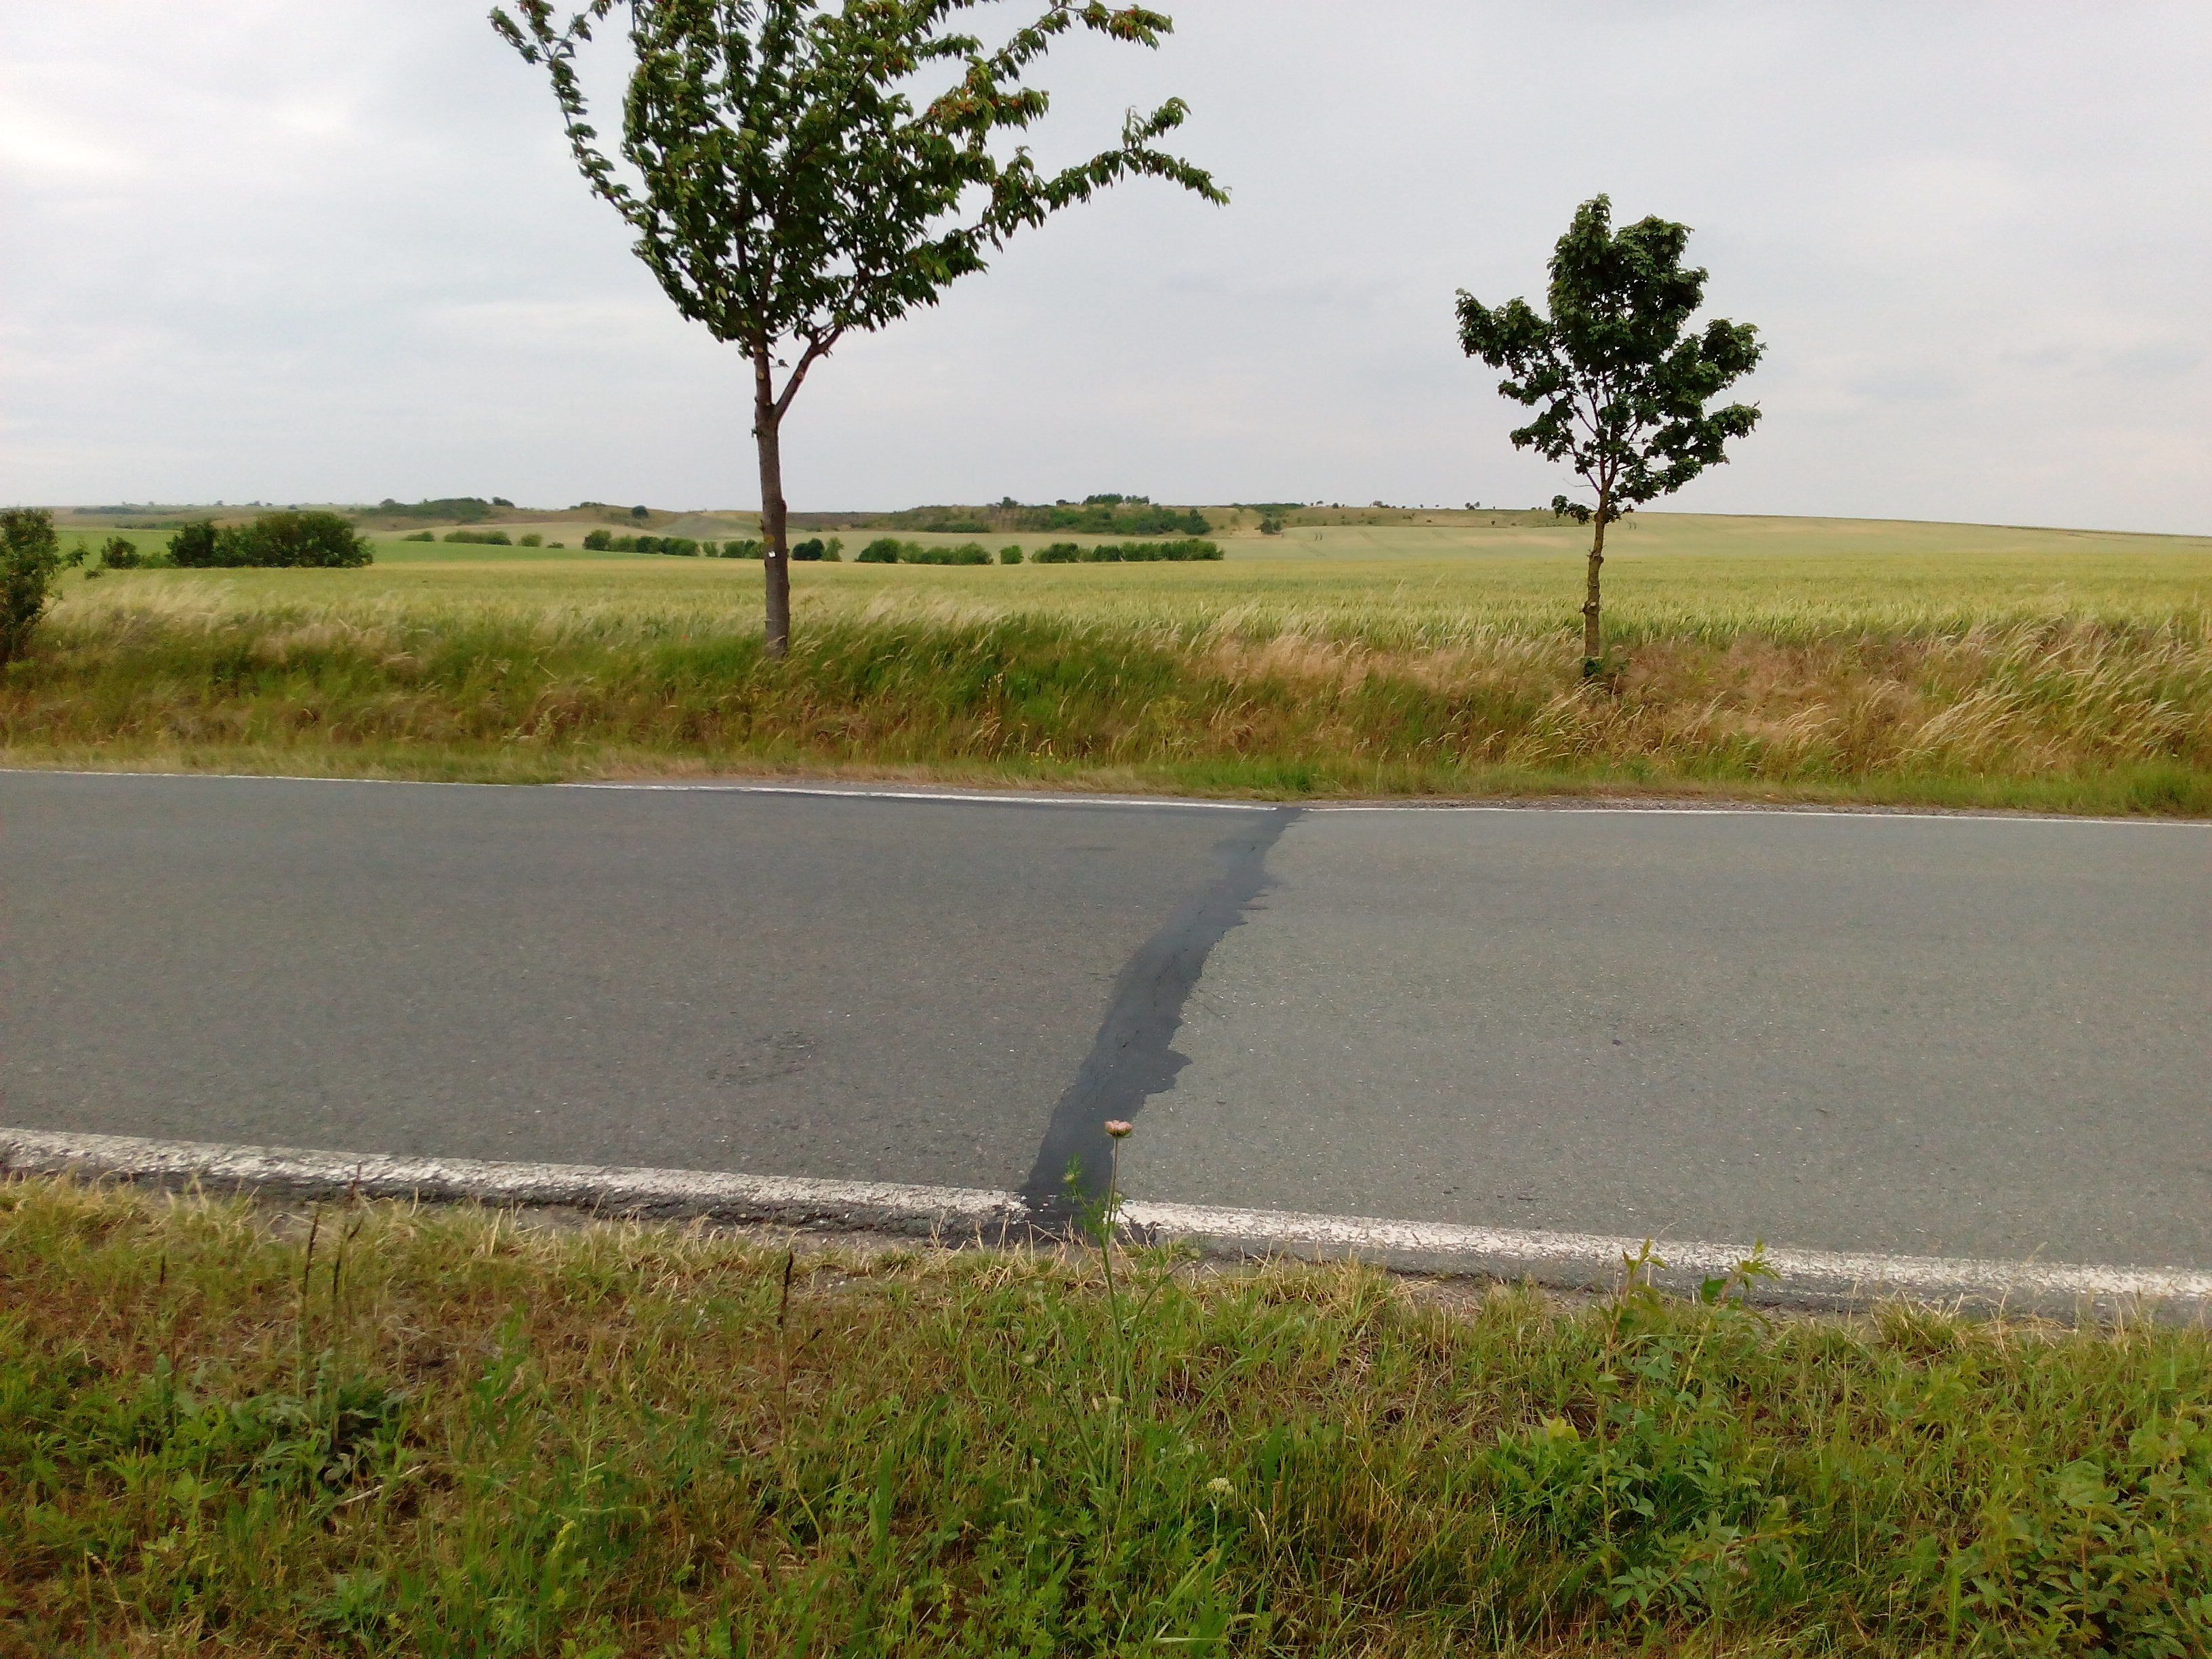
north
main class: Grassland
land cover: Grassland without tree/shrub cover
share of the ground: > 75 %
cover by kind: herbaceous plants 95 %, shrubs 5 %
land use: Agriculture (excluding fallow land and kitchen gardens)
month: June
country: DE
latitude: 51.2221
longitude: 11.0736
